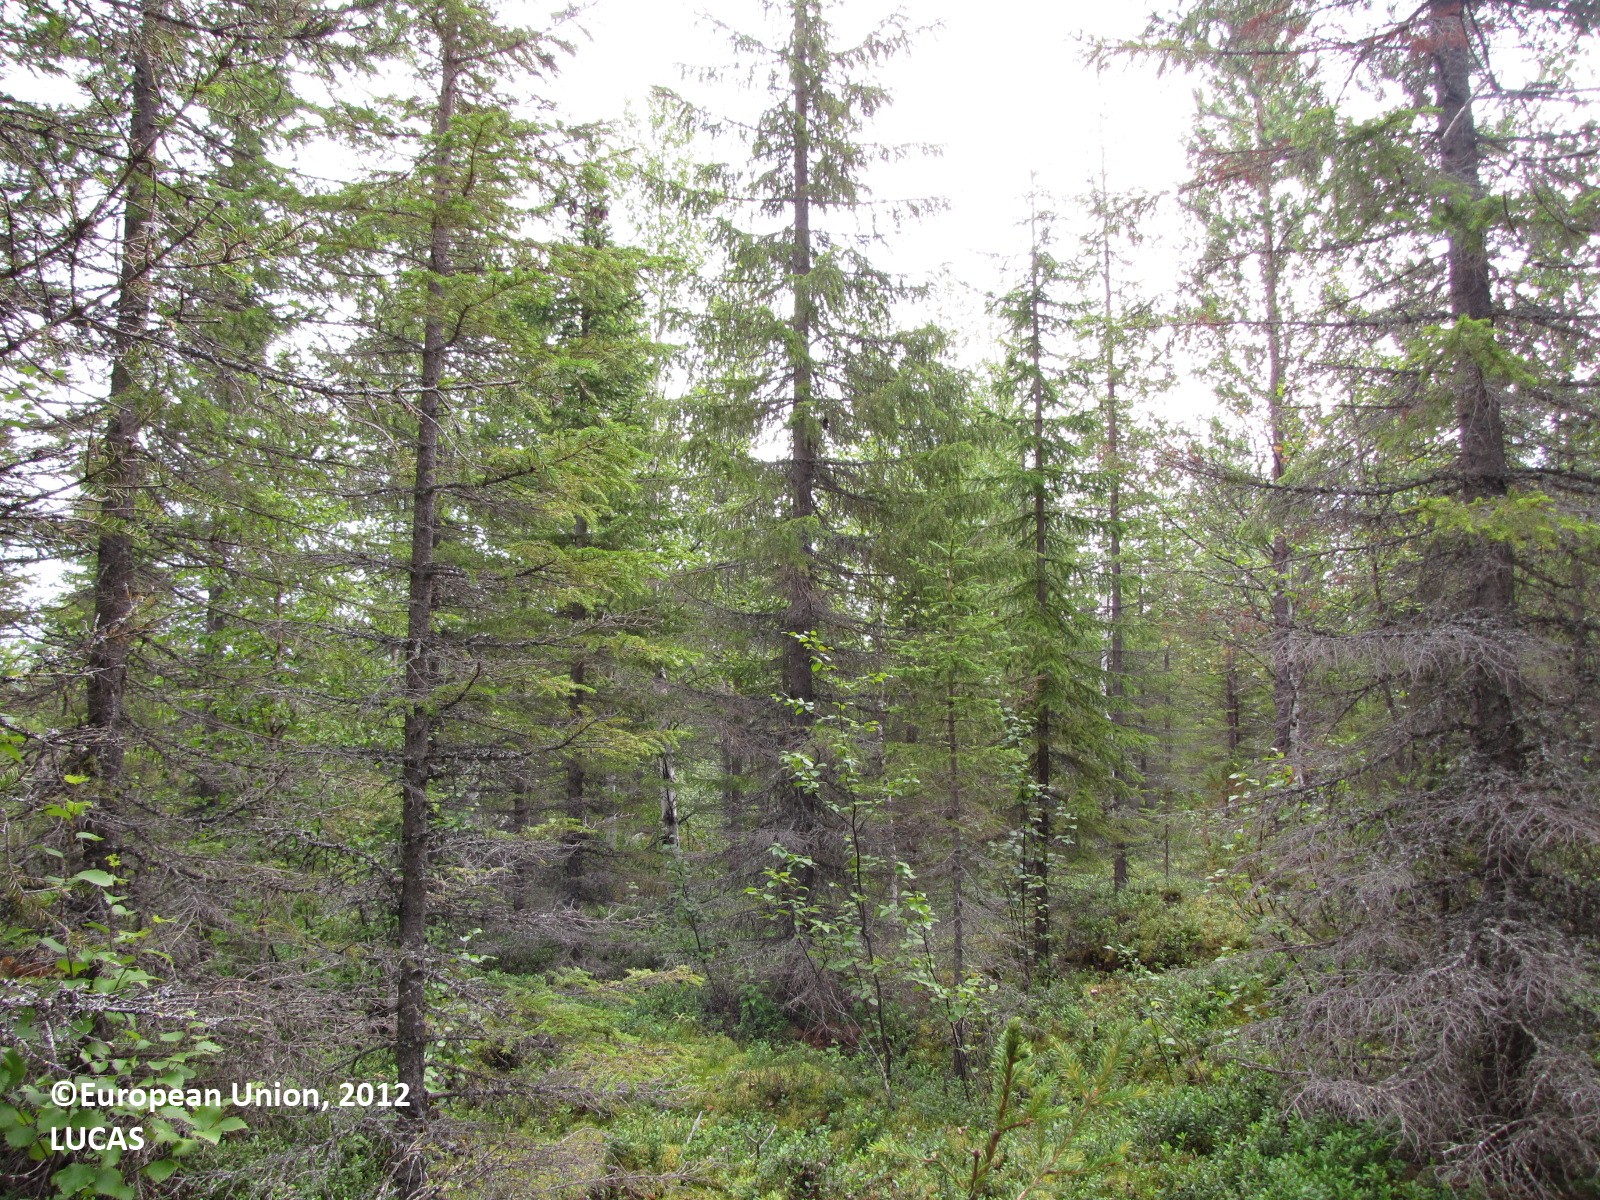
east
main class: Woodland
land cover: Spruce dominated coniferous woodland
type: boreal forest
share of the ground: 25 - 50 %
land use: Forestry
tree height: > 5 m
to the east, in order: Spruce dominated coniferous woodland; Spruce dominated mixed woodland; Inland water bodies
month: August
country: FI
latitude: 66.8385
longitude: 24.6005
